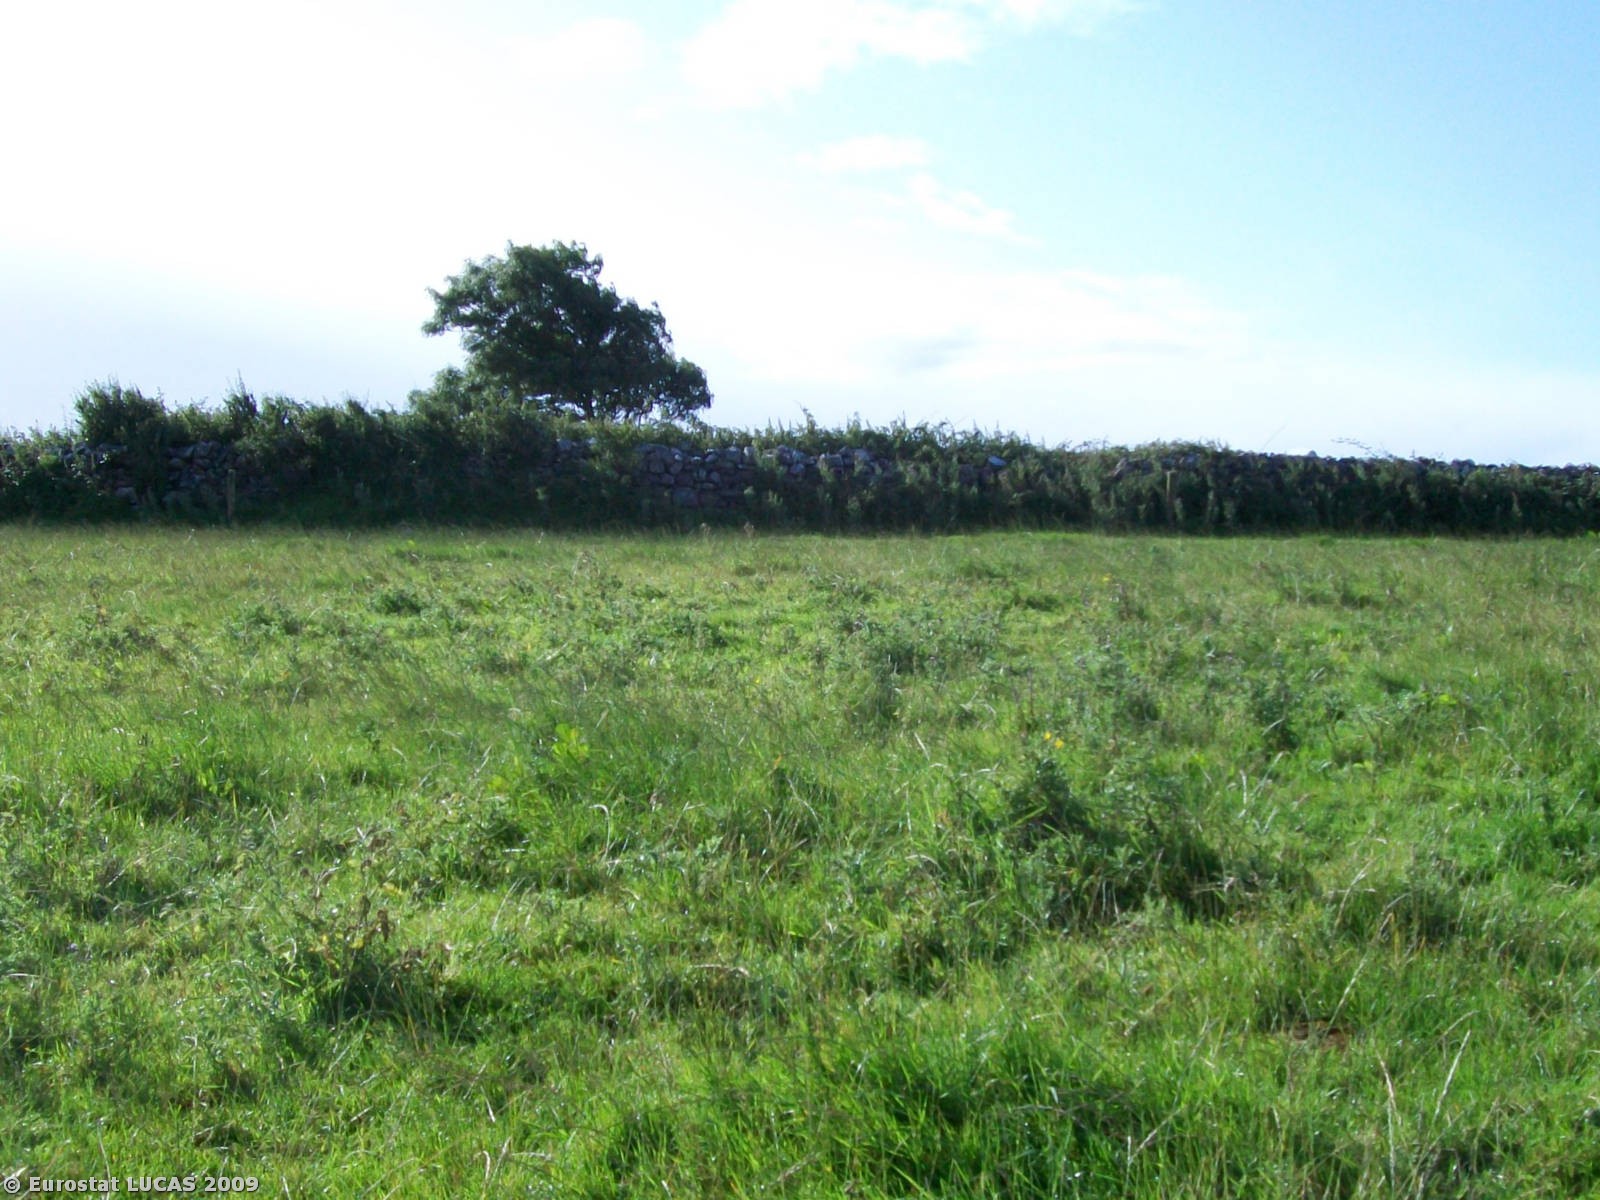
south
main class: Grassland
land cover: Grassland without tree/shrub cover
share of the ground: > 75 %
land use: Agriculture (excluding fallow land and kitchen gardens)
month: August
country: IE
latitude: 52.9890
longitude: -9.2148
